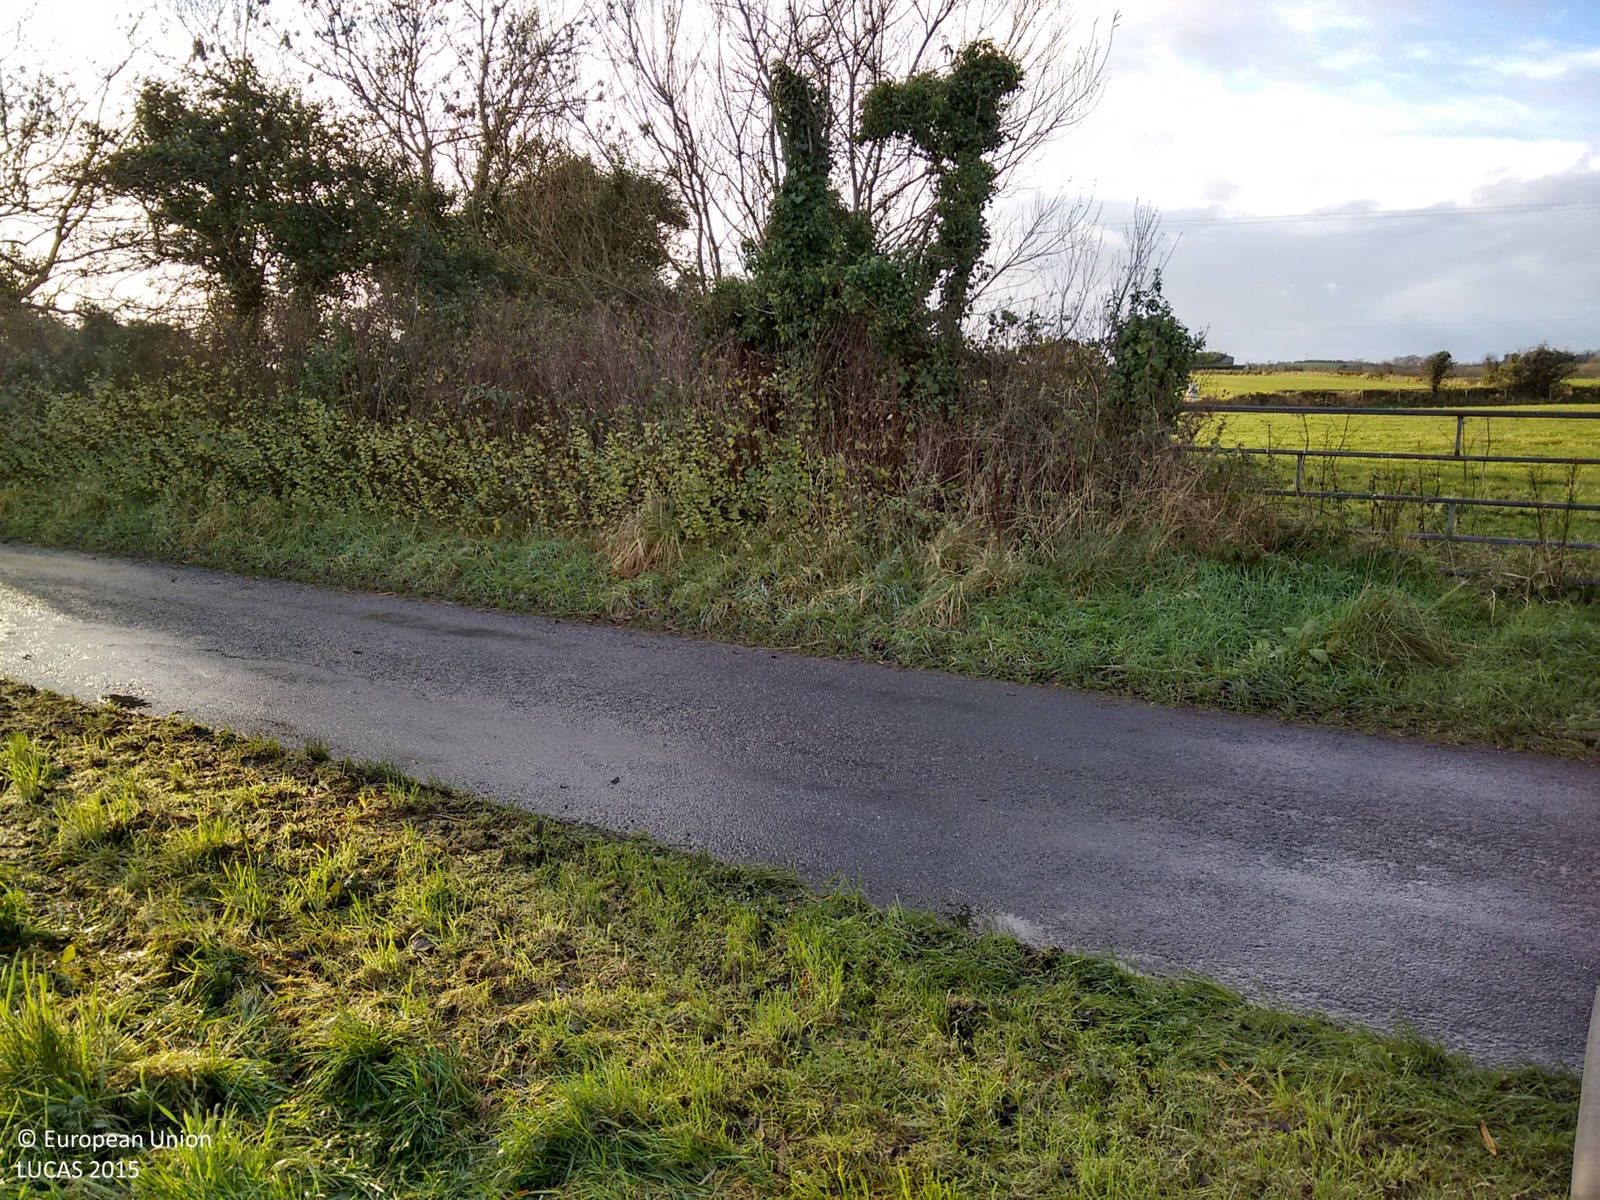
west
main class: Grassland
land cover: Grassland without tree/shrub cover
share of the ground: > 75 %
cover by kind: herbaceous plants 100 %
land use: Agriculture (excluding fallow land and kitchen gardens)
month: November
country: GB
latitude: 54.5220
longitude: -5.4998
